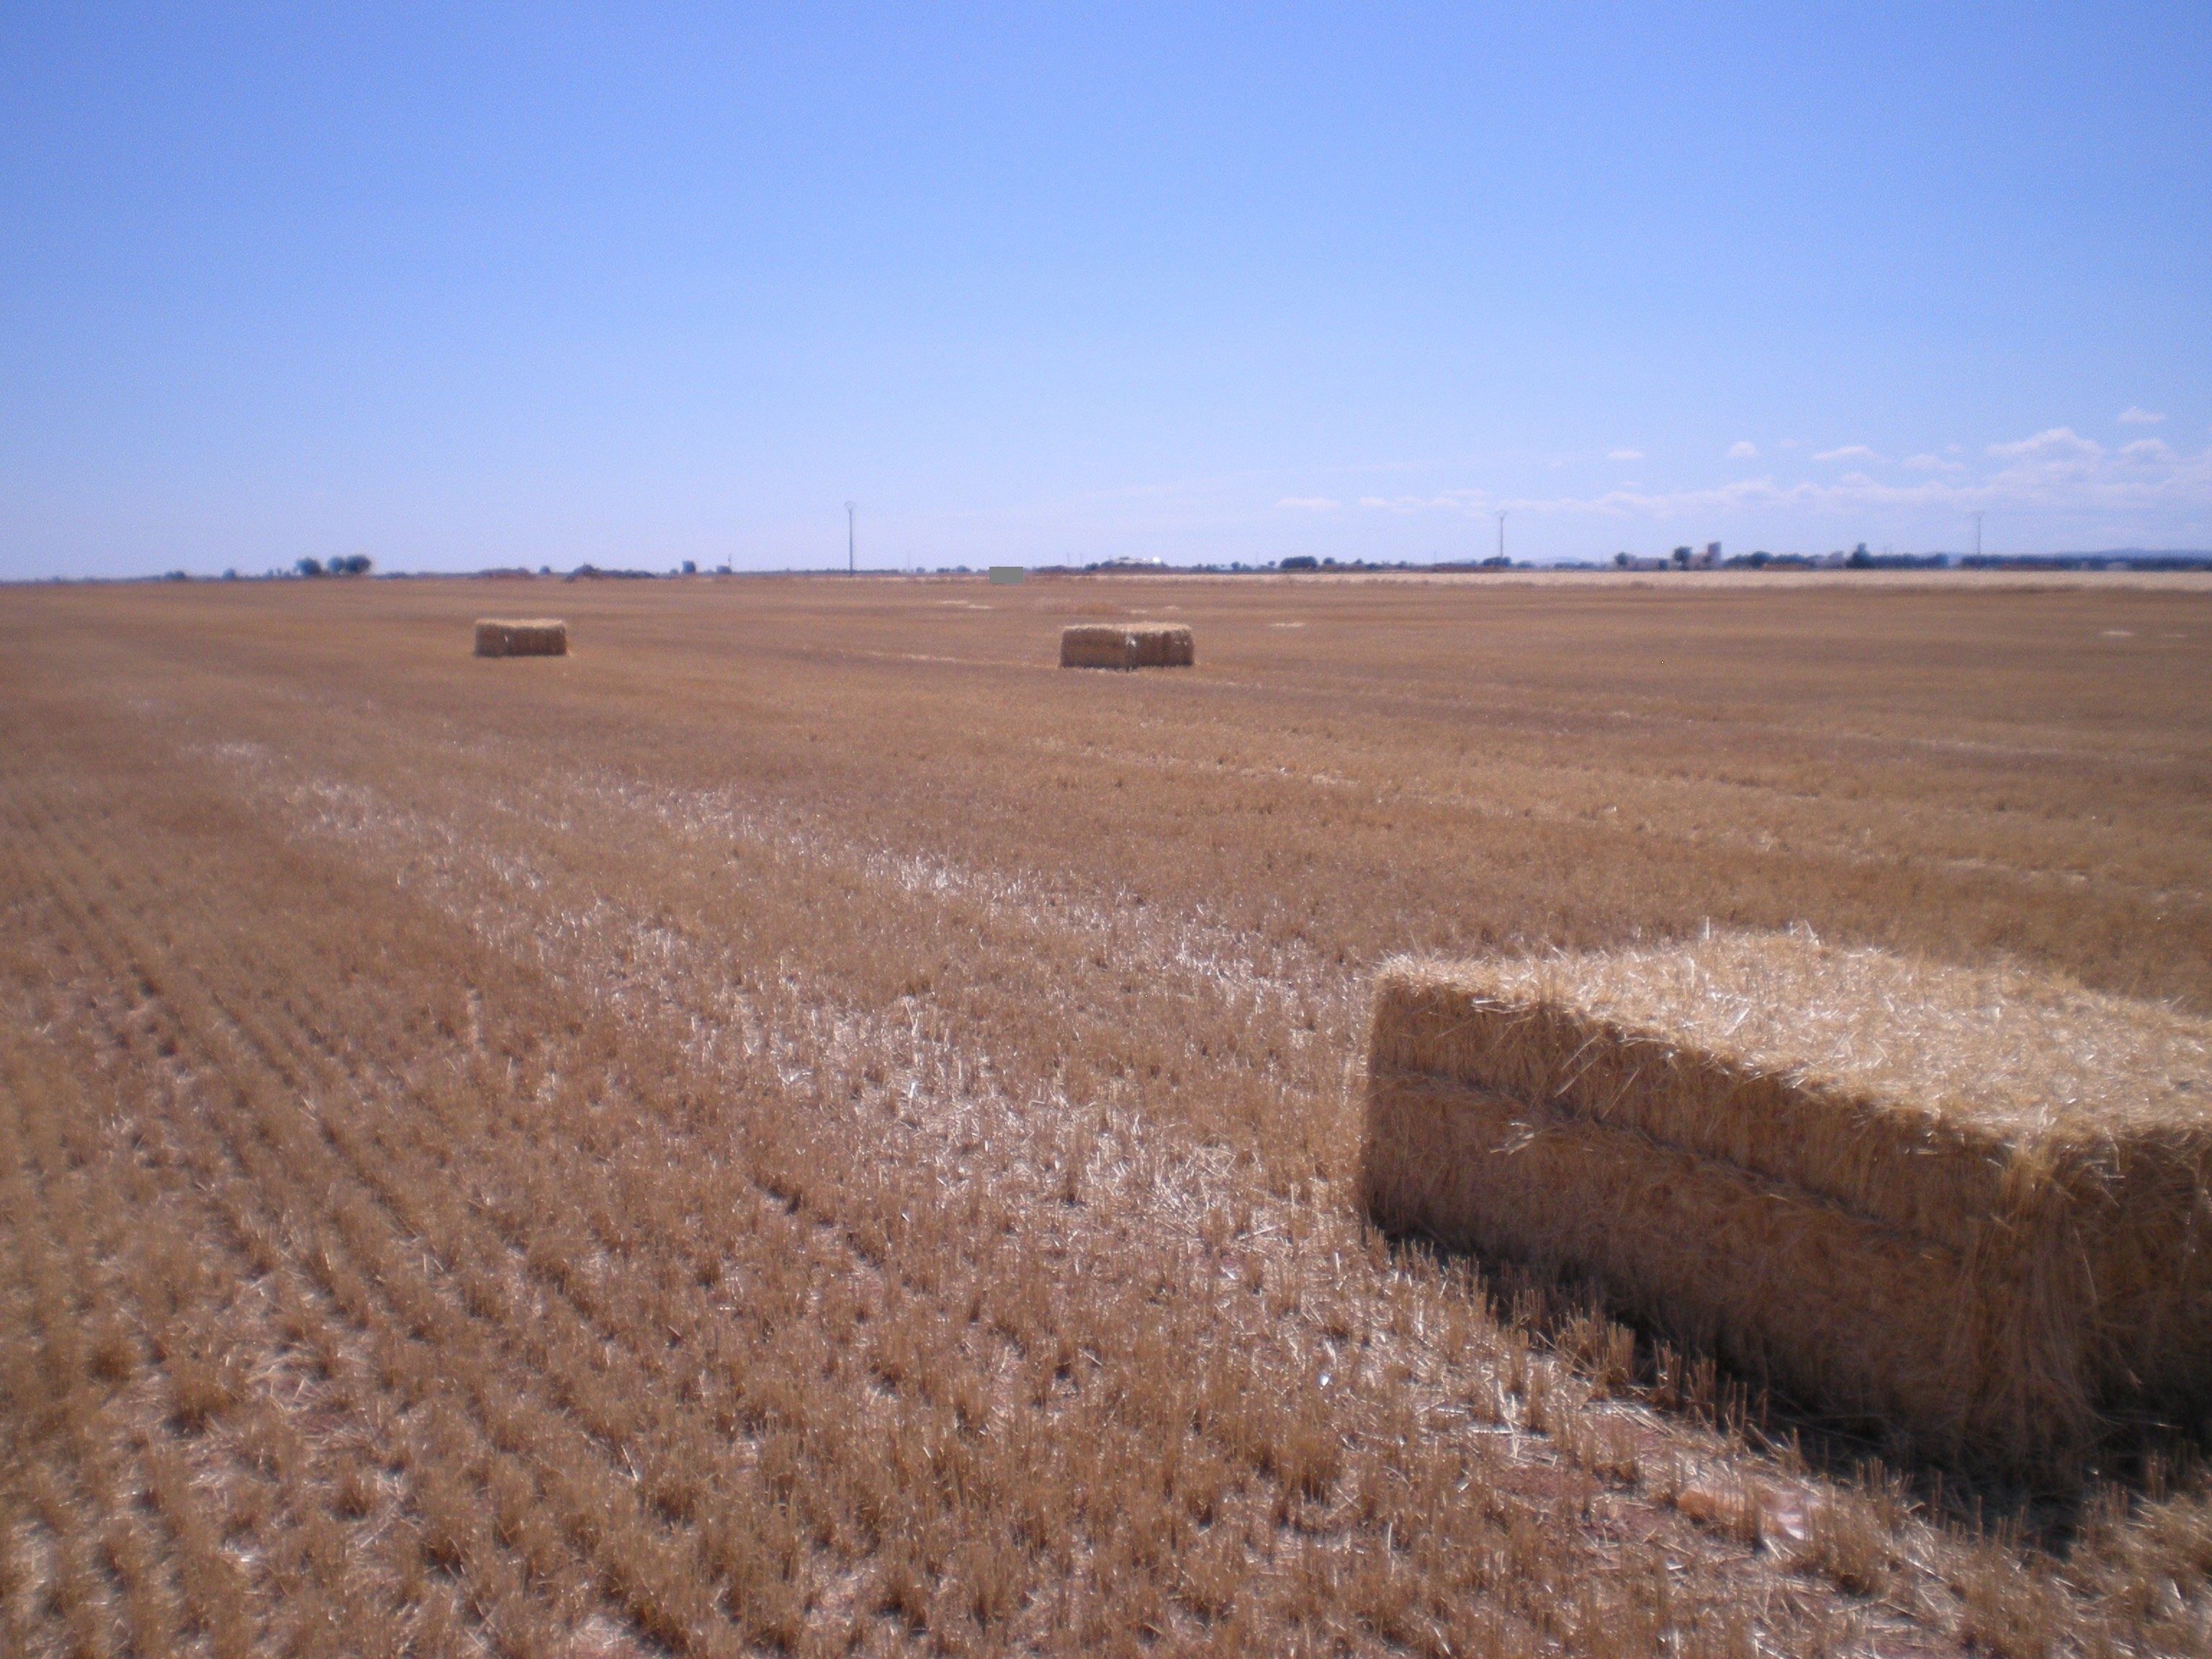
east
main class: Cropland
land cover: Barley
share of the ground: > 75 %
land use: Agriculture (excluding fallow land and kitchen gardens)
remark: Harvested field
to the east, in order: Barley
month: June
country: ES
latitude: 39.1794
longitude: -3.1297
